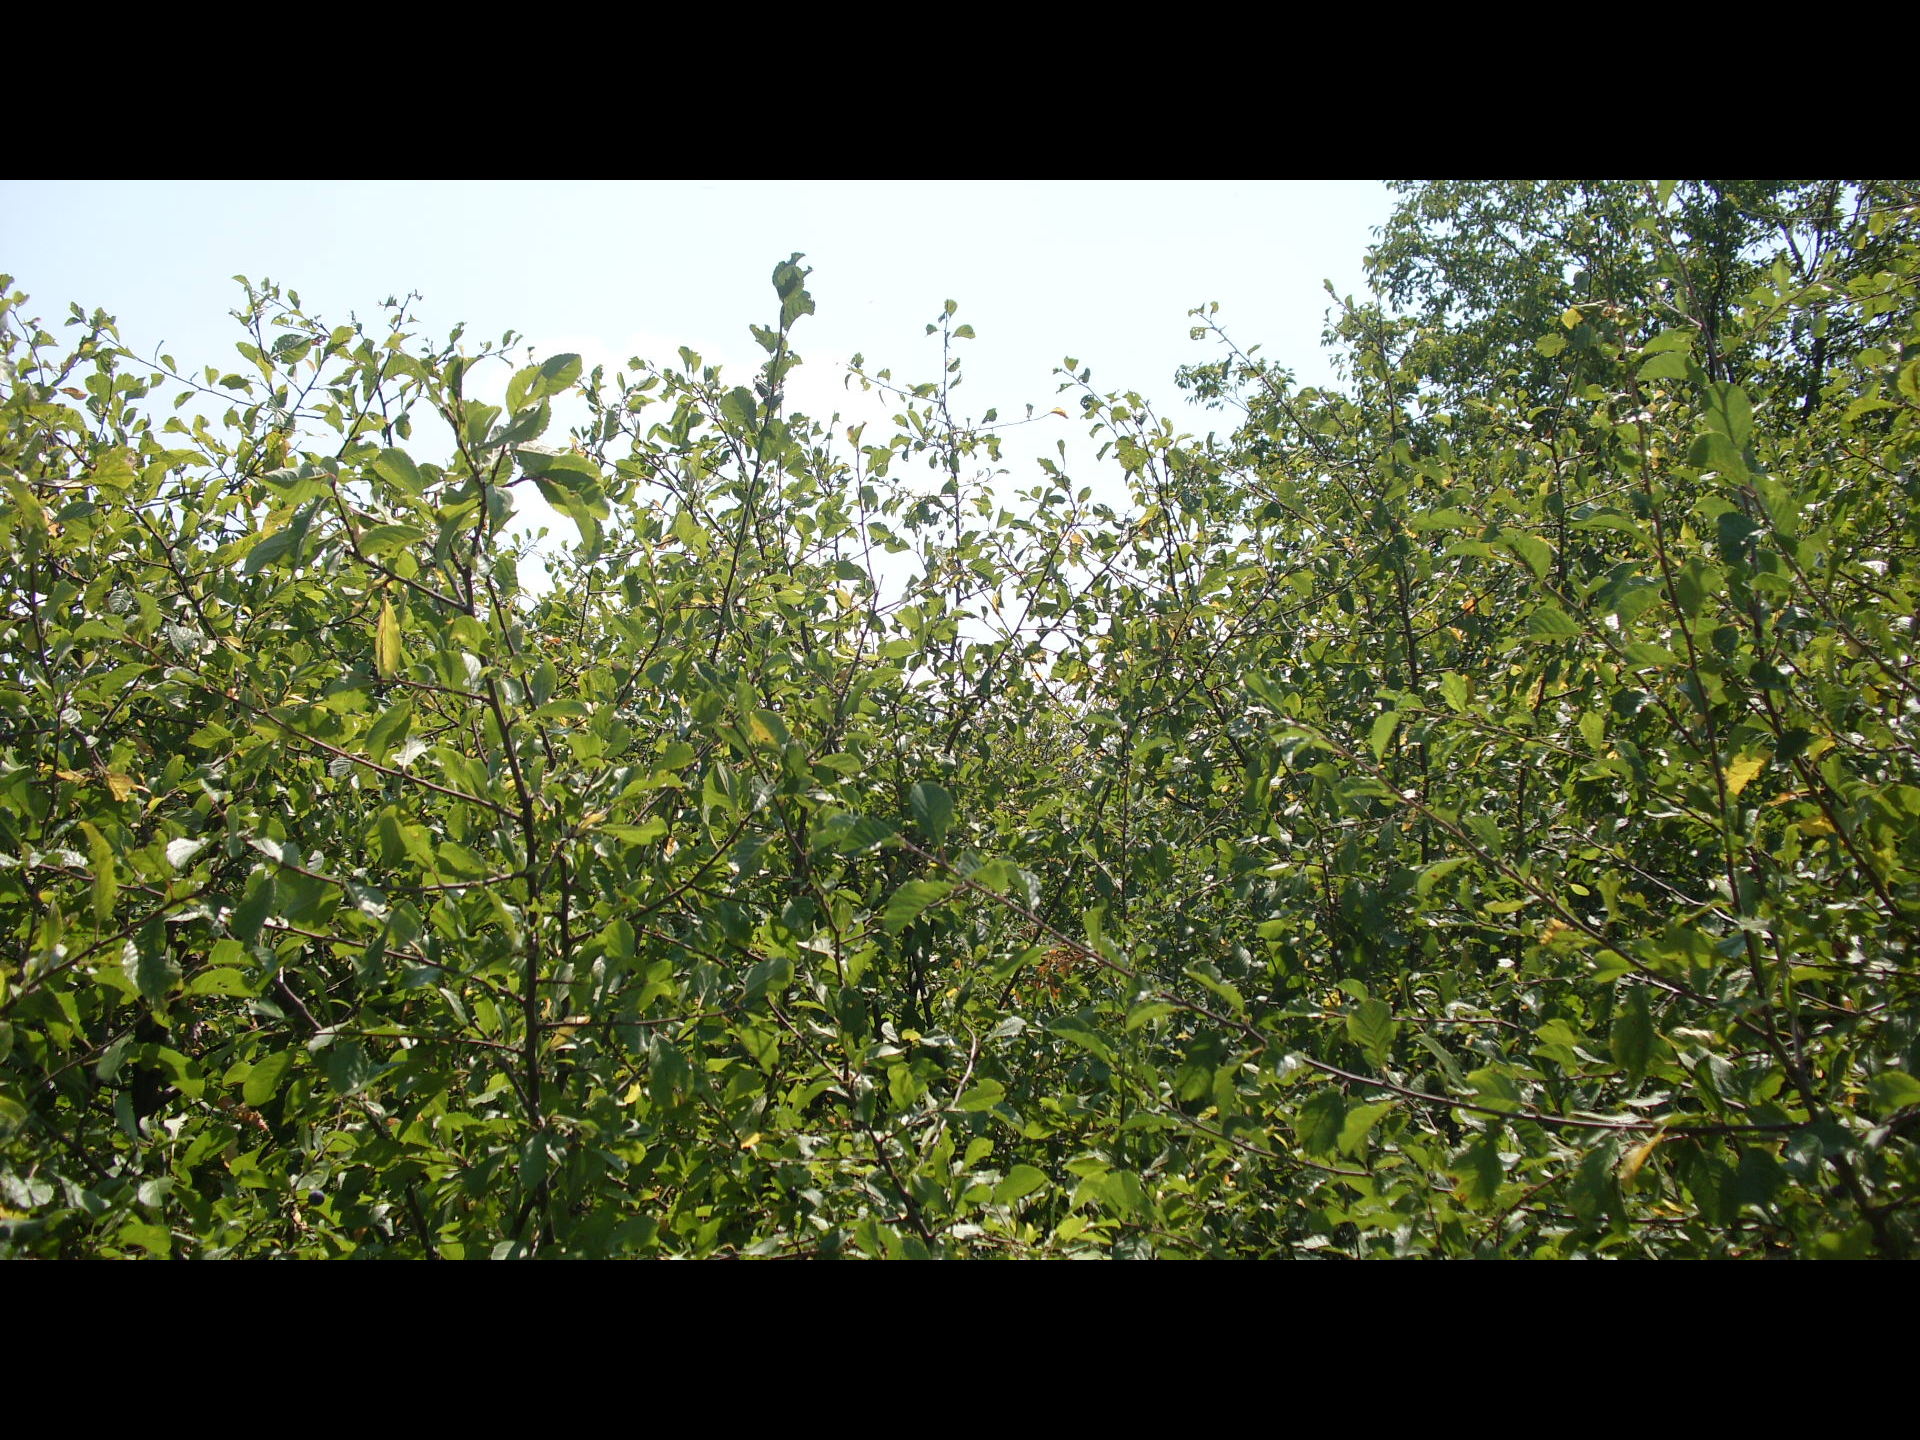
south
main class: Shrubland
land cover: Shrubland without tree cover
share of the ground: > 75 %
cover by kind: shrubs 95 %, herbaceous plants 5 %
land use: Agriculture (excluding fallow land and kitchen gardens)
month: August
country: BG
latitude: 43.2988
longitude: 23.3658
